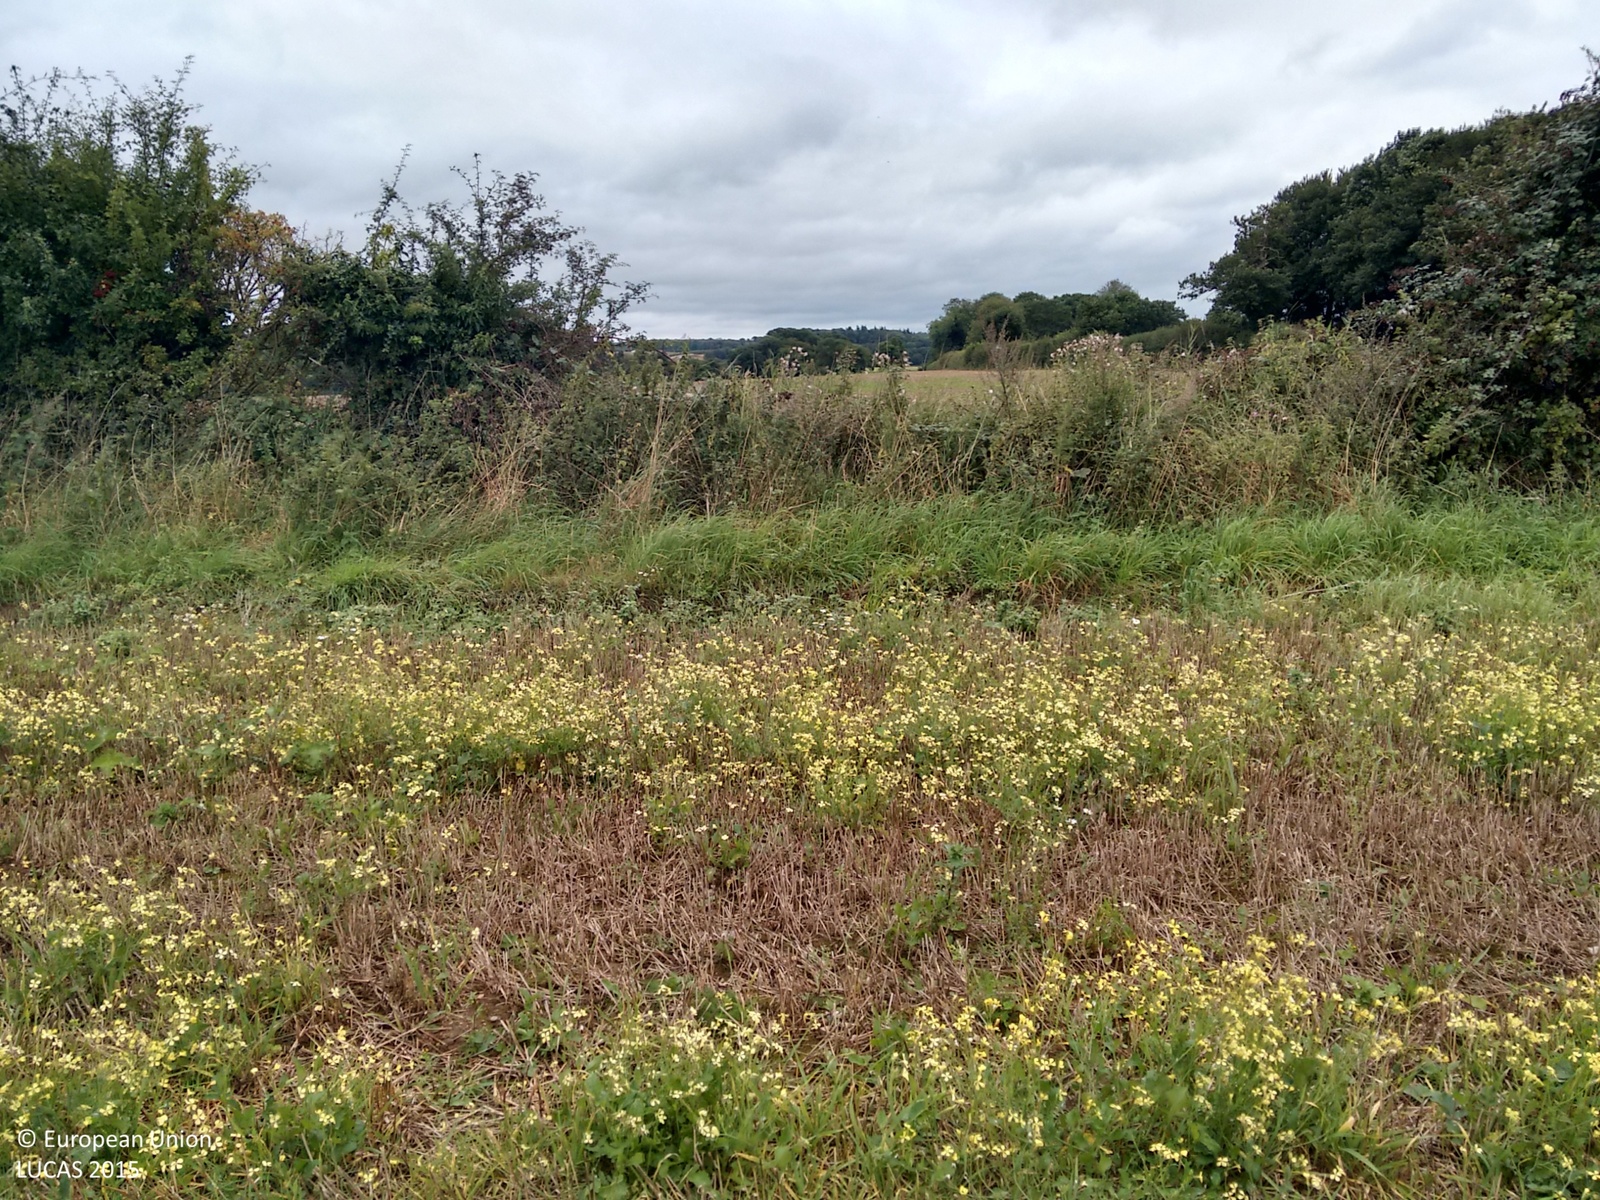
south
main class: Cropland
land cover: Common wheat
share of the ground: > 75 %
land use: Agriculture (excluding fallow land and kitchen gardens)
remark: Harvested field
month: September
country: GB
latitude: 52.6945
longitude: 1.3537
